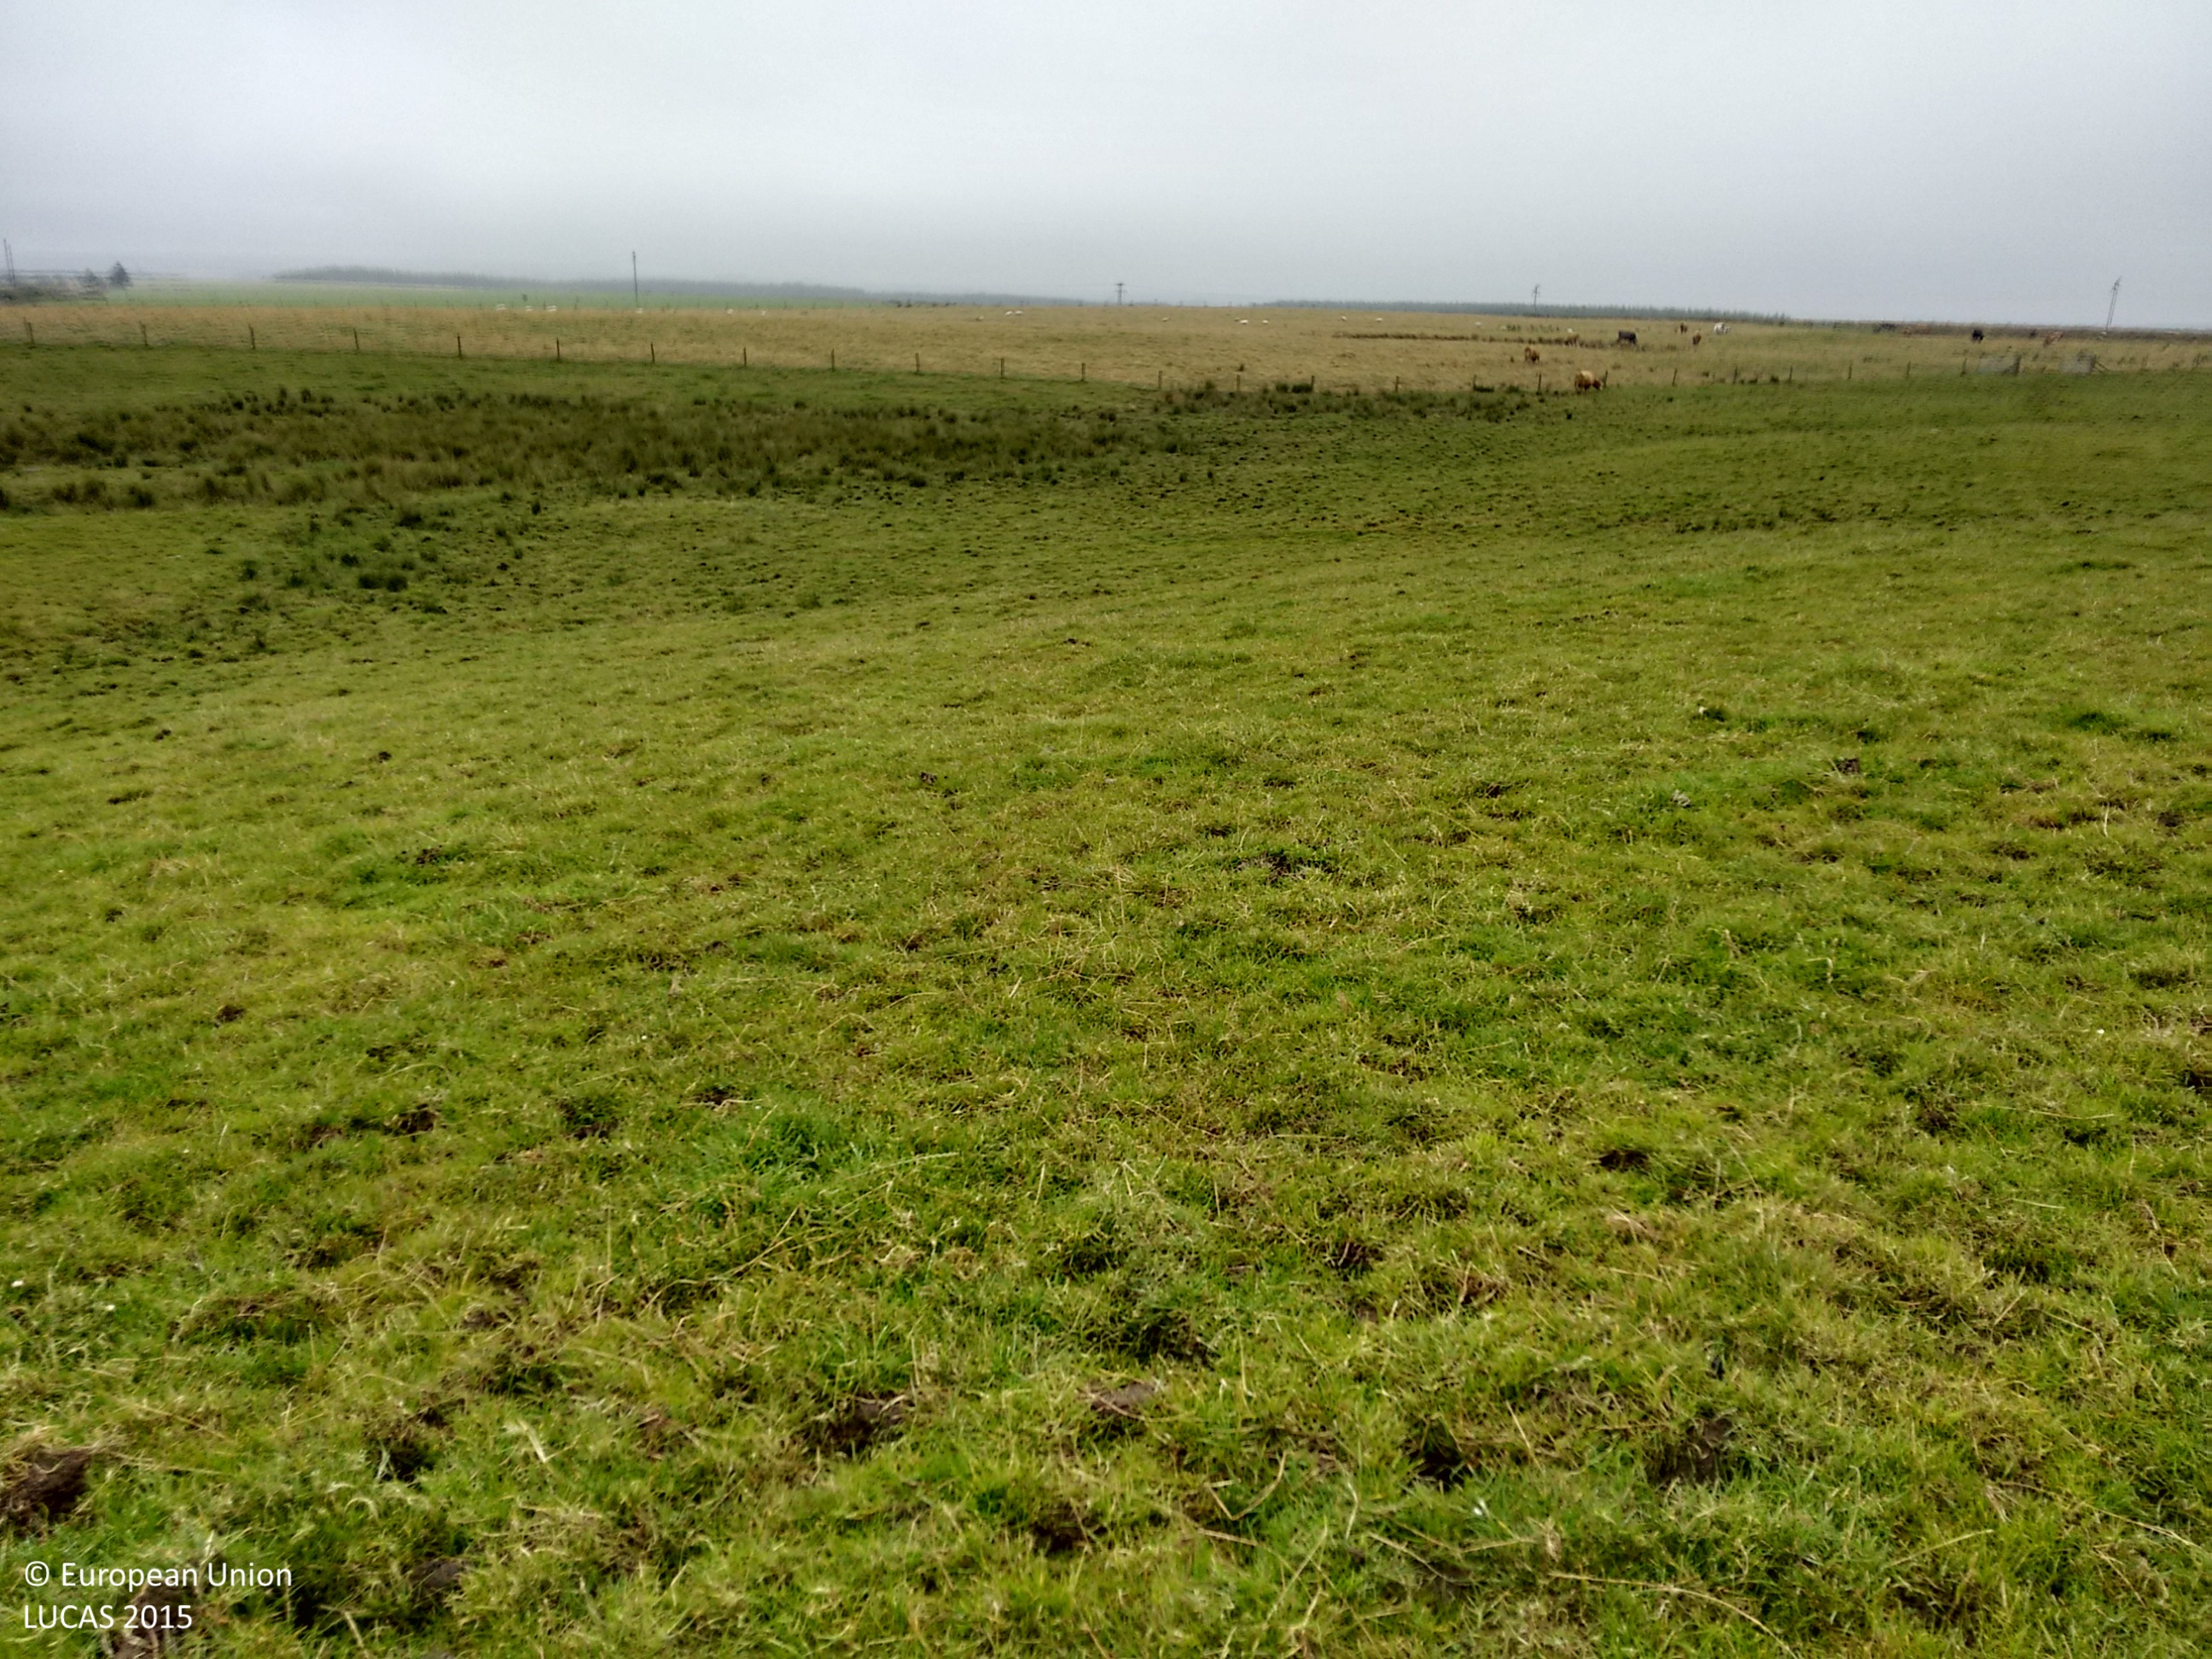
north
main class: Grassland
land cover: Grassland without tree/shrub cover
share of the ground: > 75 %
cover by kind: herbaceous plants 100 %
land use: Agriculture (excluding fallow land and kitchen gardens)
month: August
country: GB
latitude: 58.4526
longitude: -3.2727
